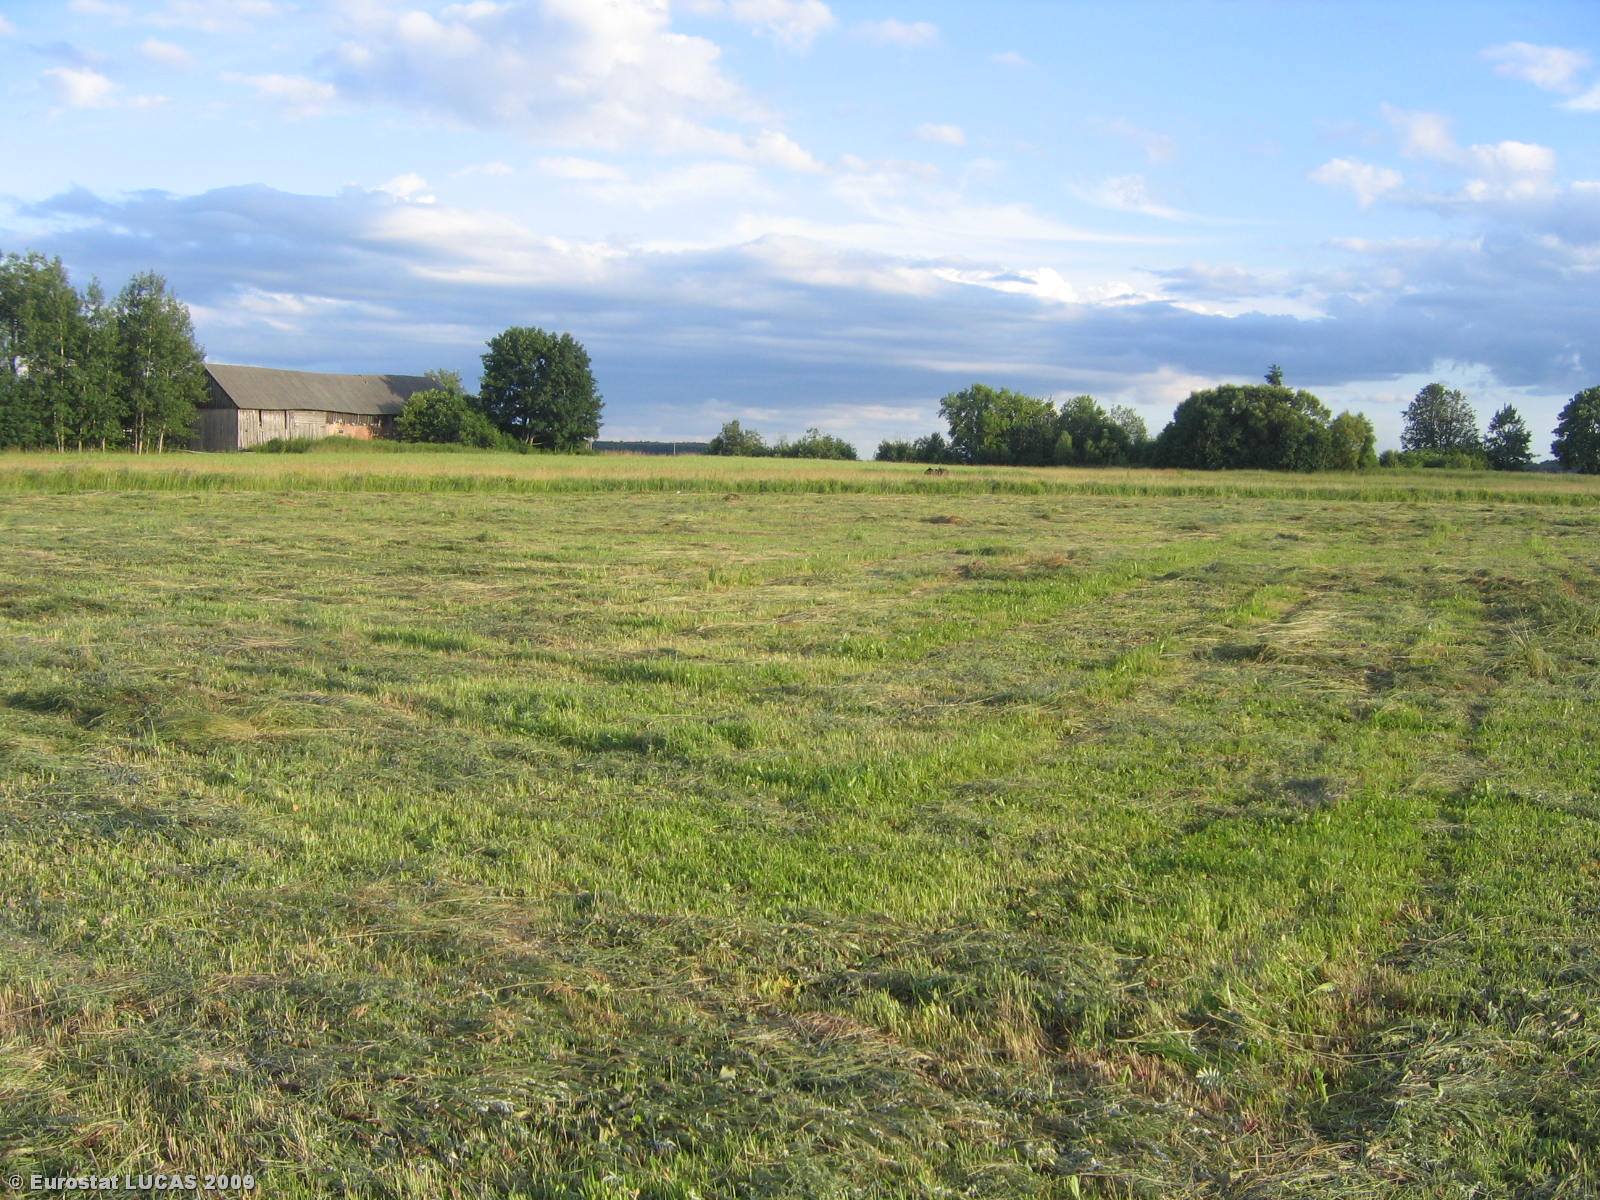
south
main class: Grassland
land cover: Grassland without tree/shrub cover
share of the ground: > 75 %
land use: Agriculture (excluding fallow land and kitchen gardens)
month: July
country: LT
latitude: 55.4030
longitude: 22.7463
